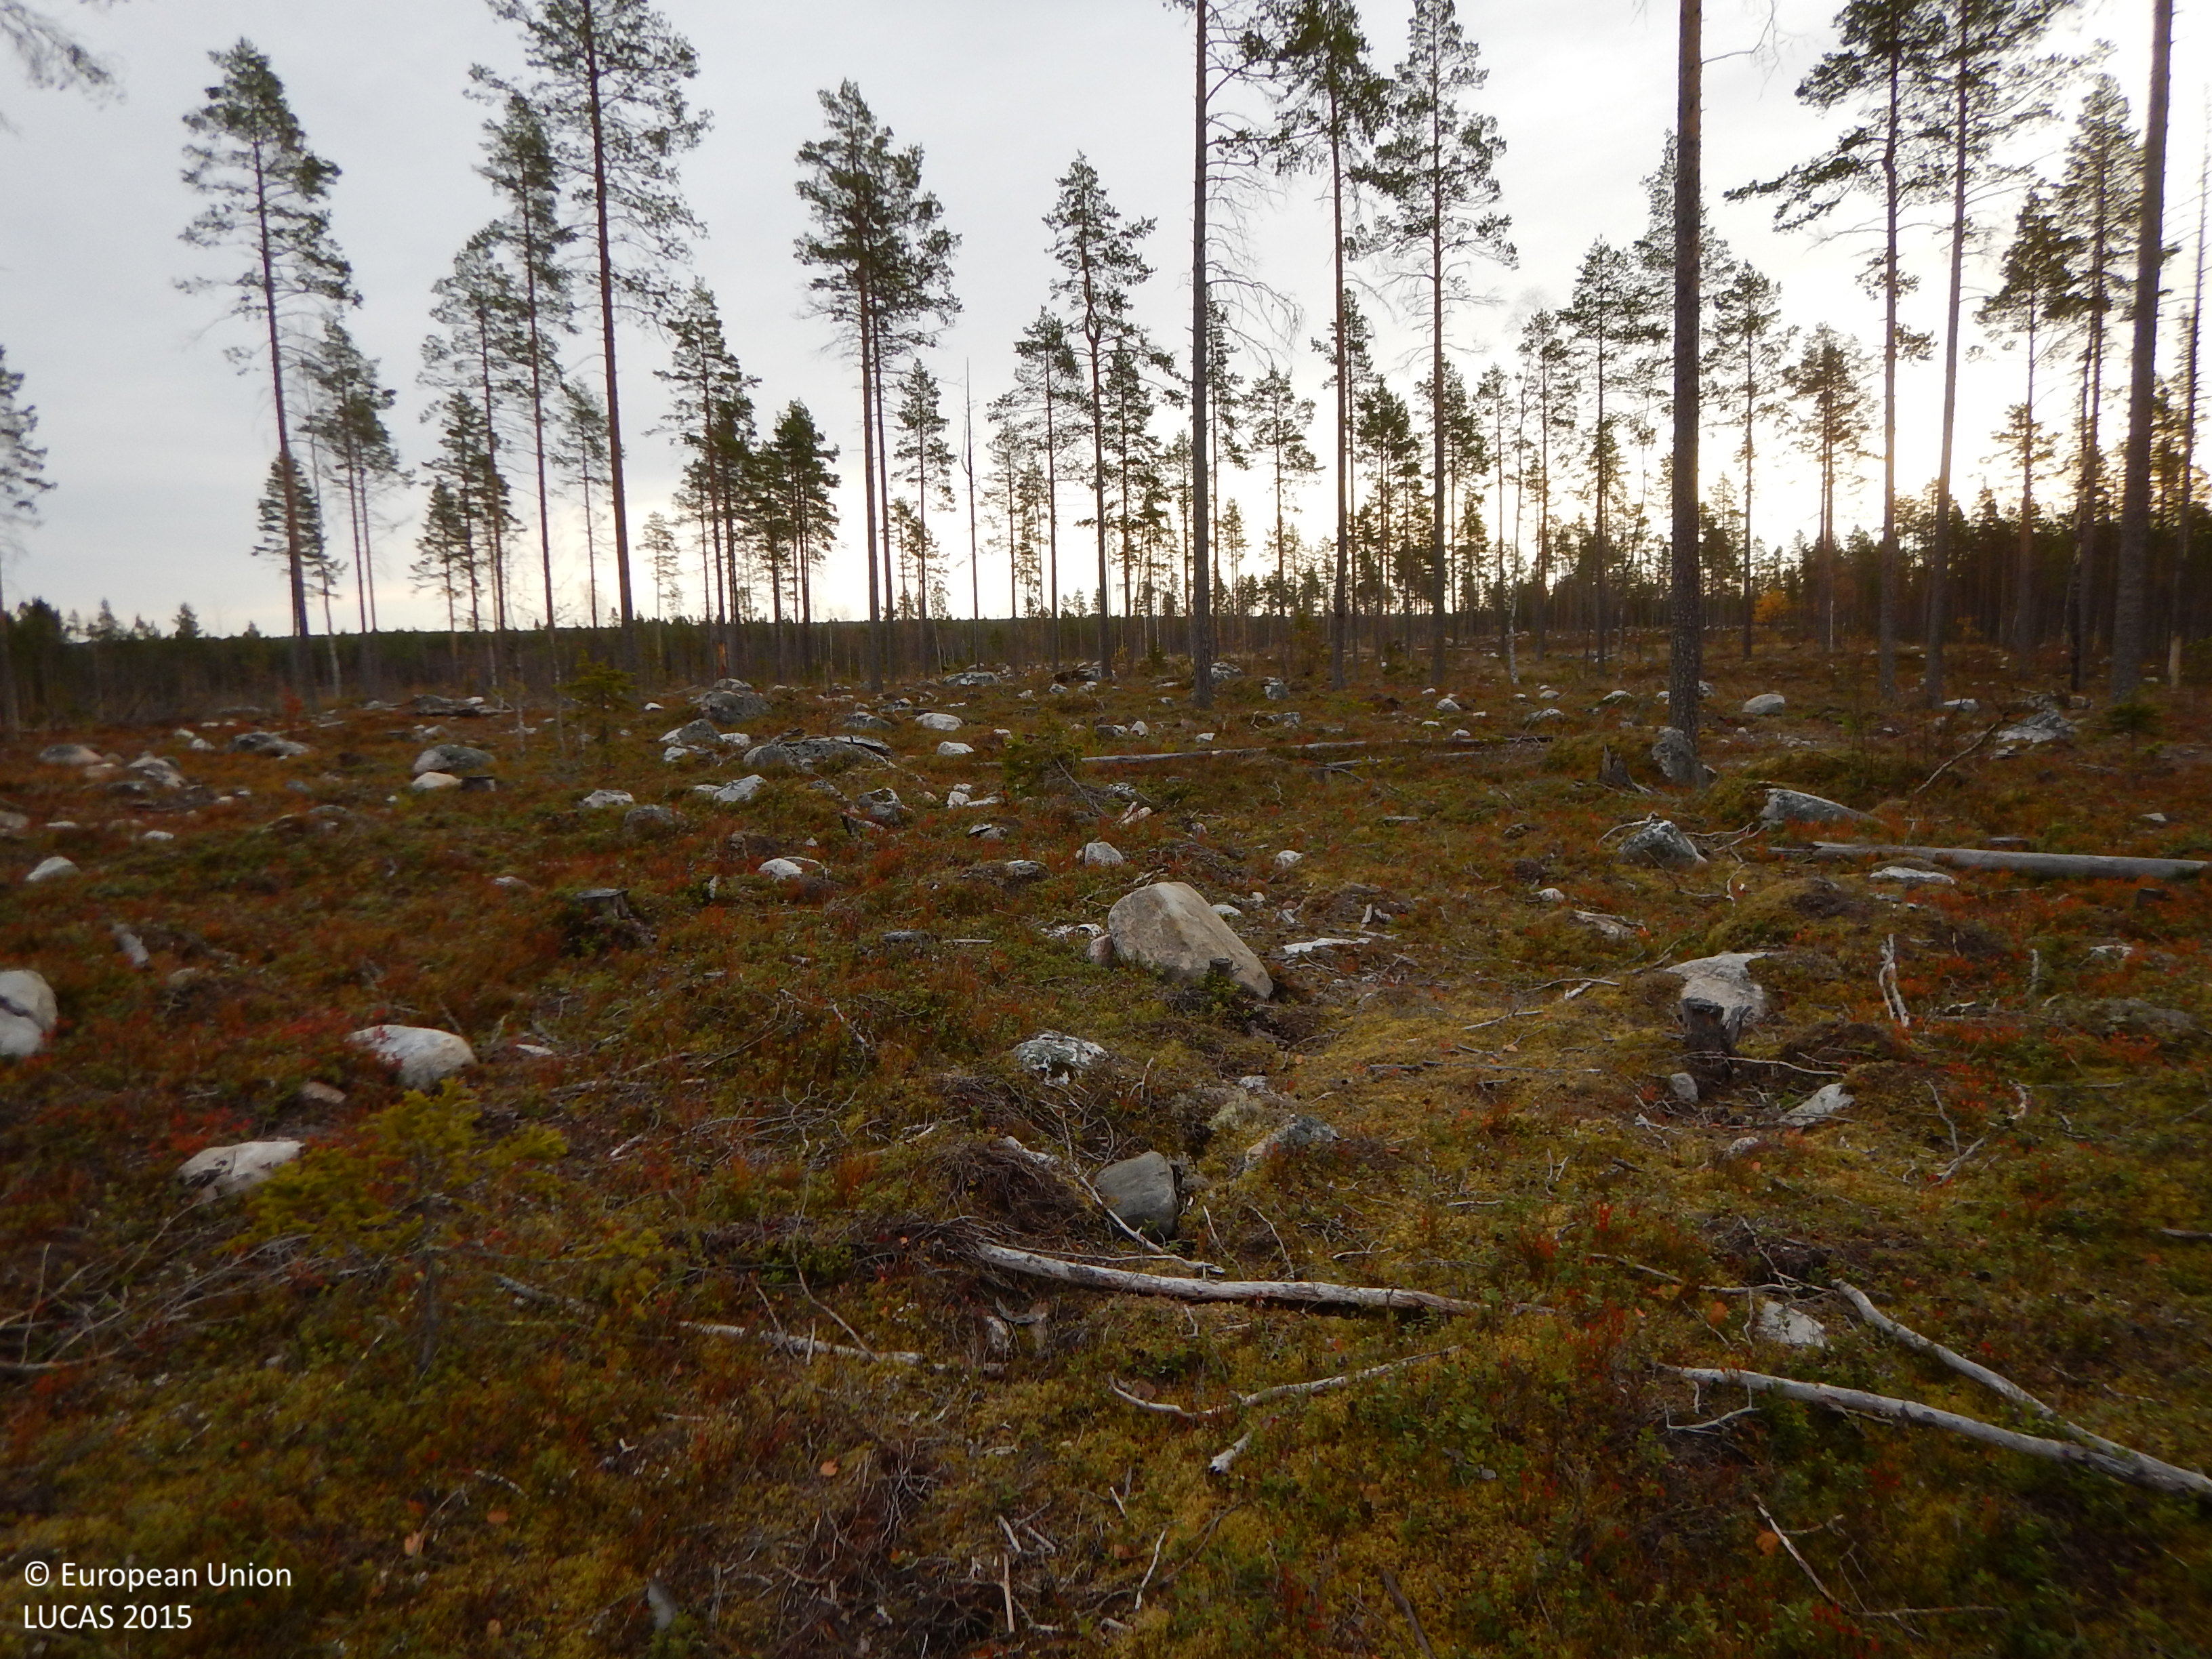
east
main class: Woodland
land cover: Pine dominated coniferous woodland
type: boreal forest
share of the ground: 10 - 25 %
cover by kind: lichens and mosses 40 %, shrubs 30 %, herbaceous plants 20 %, coniferous forest trees 10 %
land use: Forestry
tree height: > 5 m
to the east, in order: Pine dominated coniferous woodland; Other mixed woodland
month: October
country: SE
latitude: 65.1808
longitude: 21.0554
